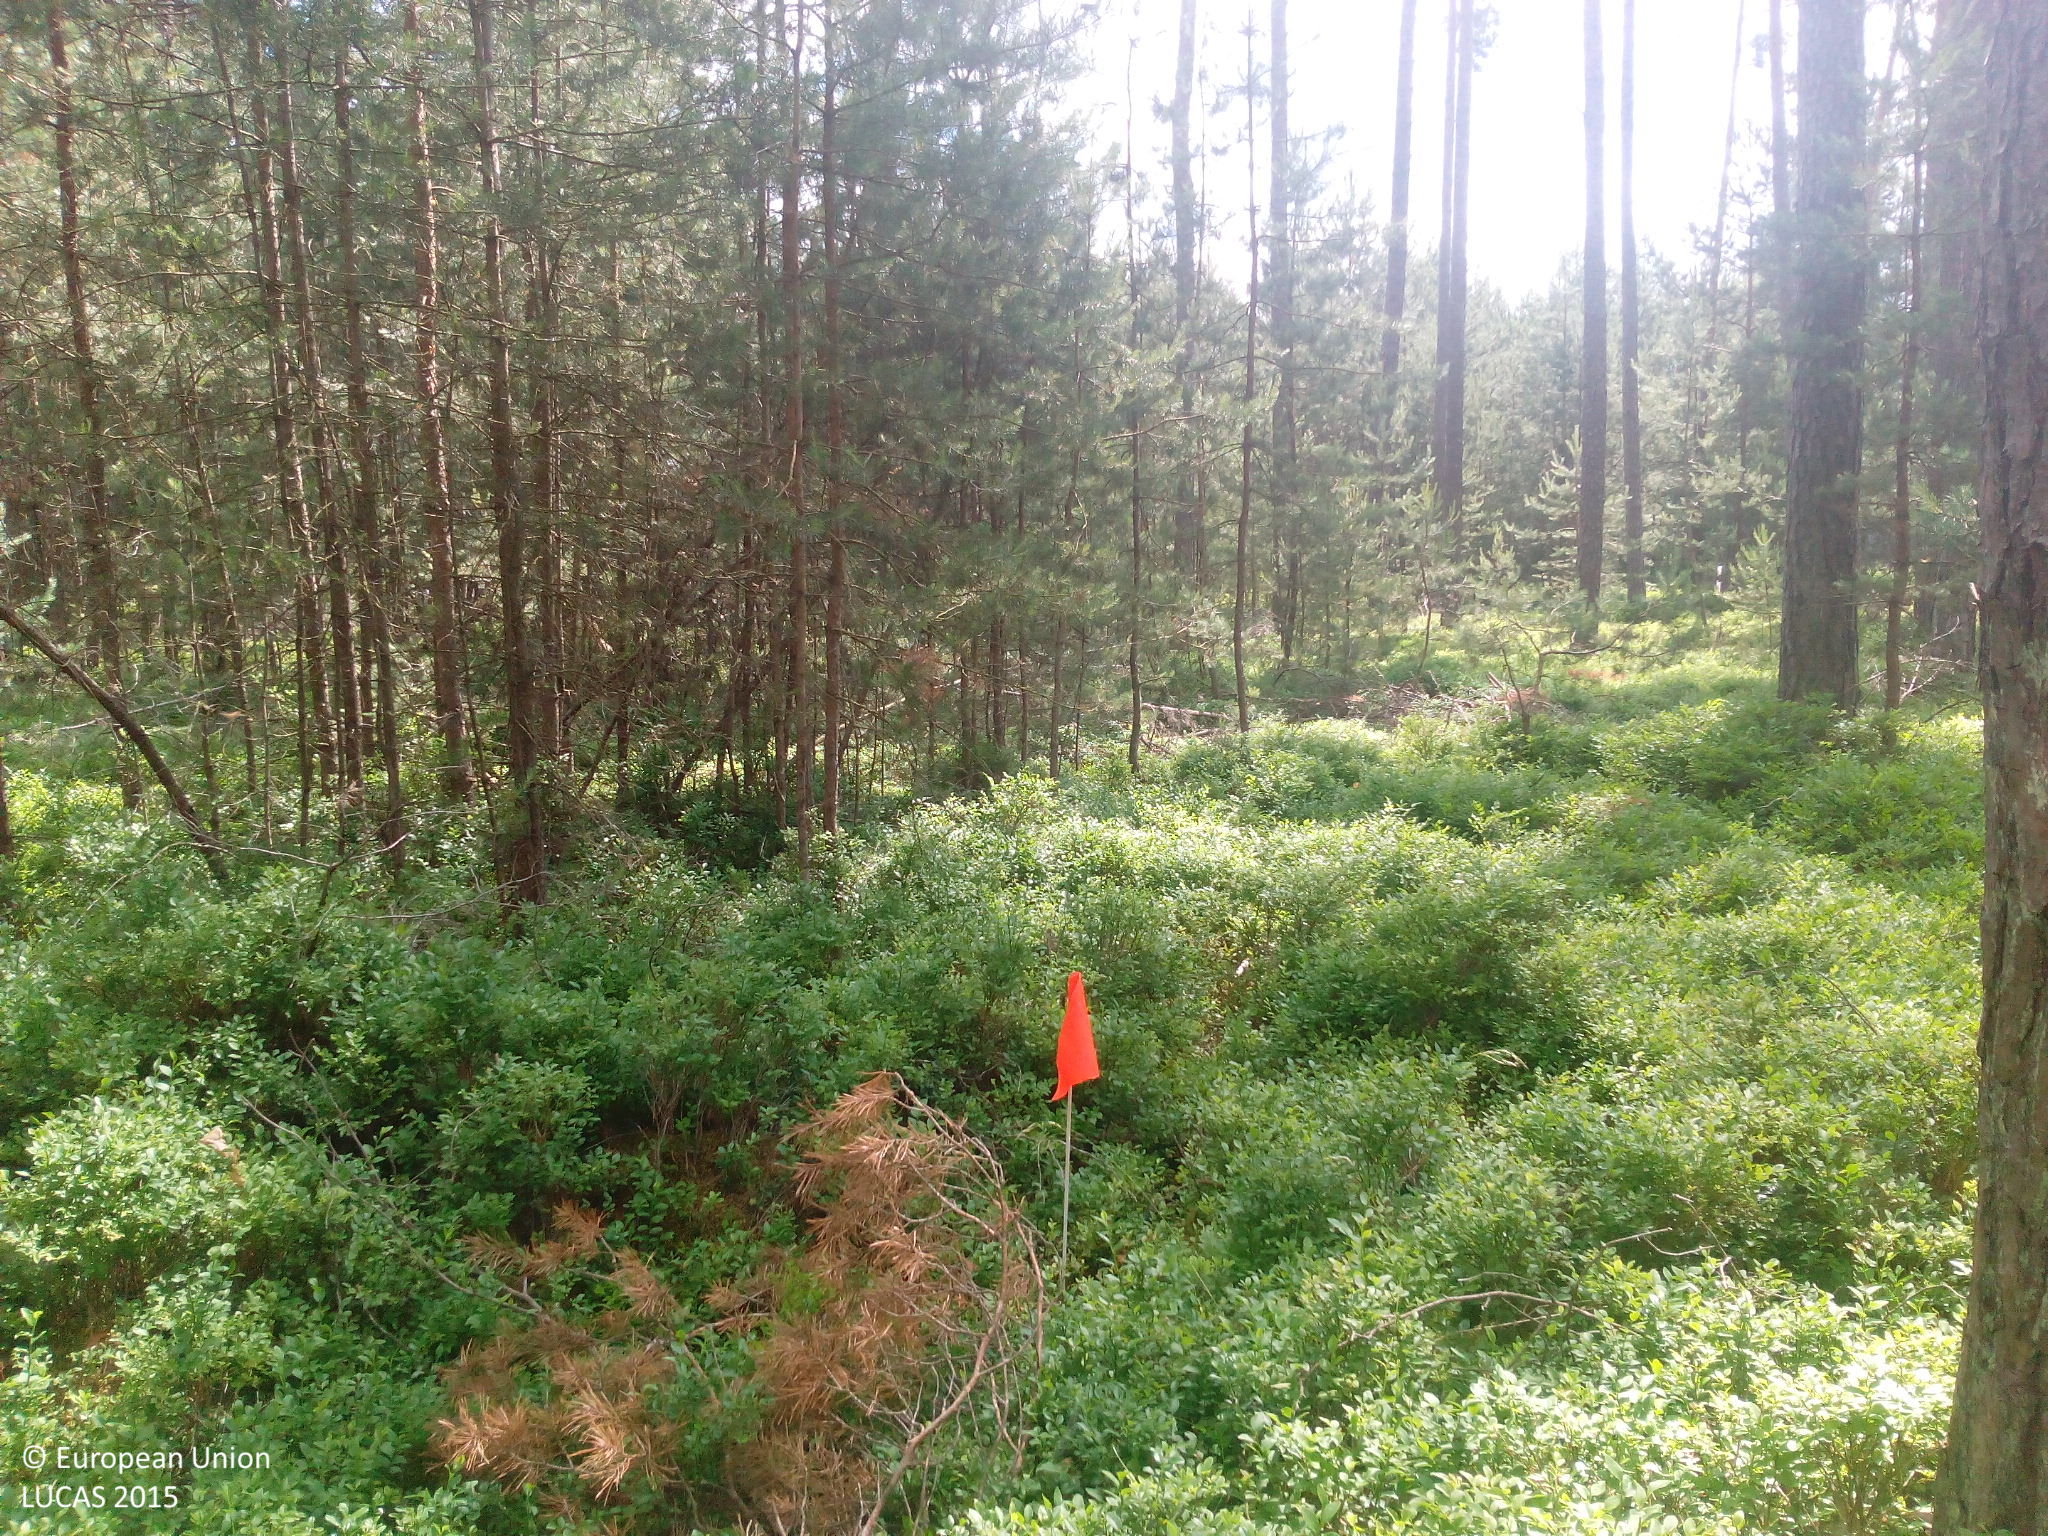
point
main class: Woodland
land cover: Pine dominated coniferous woodland
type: hemiboreal forest and nemoral coniferous forest and mixed broadleaved-coniferous forest
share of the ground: > 75 %
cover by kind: coniferous forest trees 75 %, shrubs 20 %, herbaceous plants 5 %
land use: Forestry
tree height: > 5 m
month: June
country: DE
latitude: 49.2453
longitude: 10.9200
